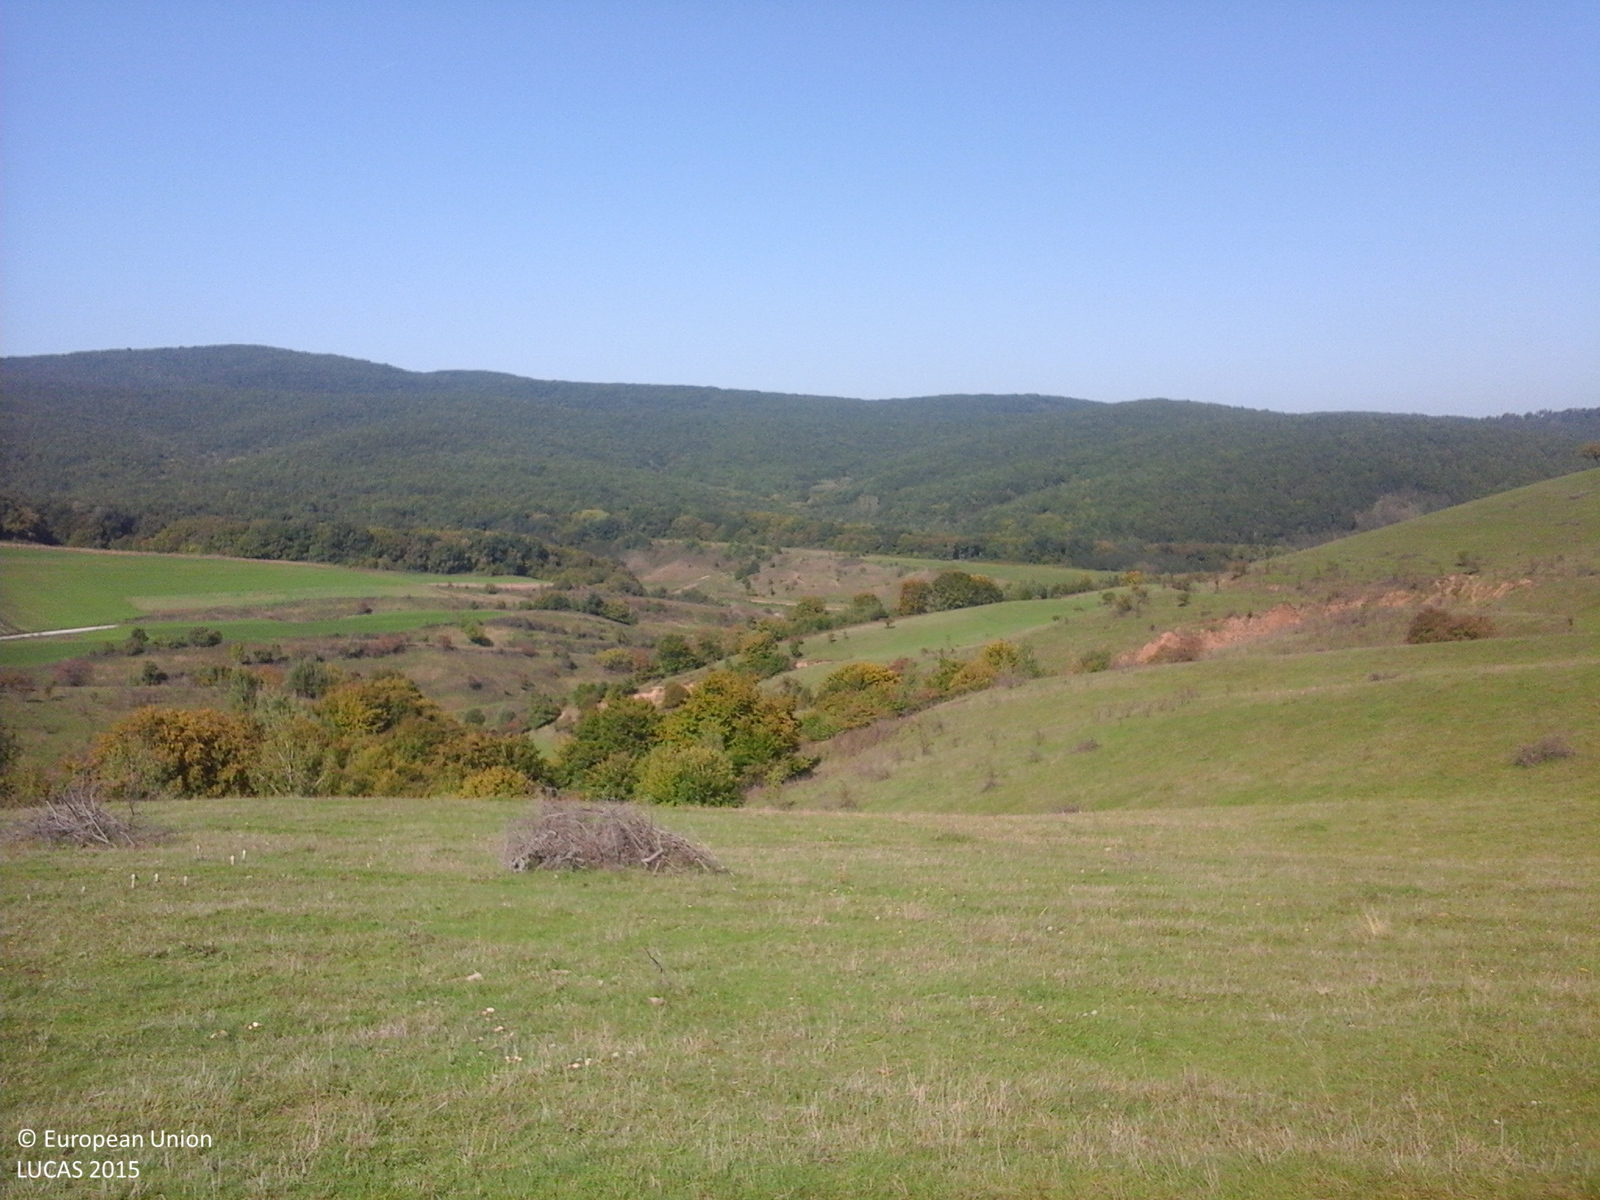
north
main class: Grassland
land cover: Grassland without tree/shrub cover
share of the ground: > 75 %
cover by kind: herbaceous plants 100 %
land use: Agriculture (excluding fallow land and kitchen gardens)
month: October
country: RO
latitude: 46.4151
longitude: 23.6921
